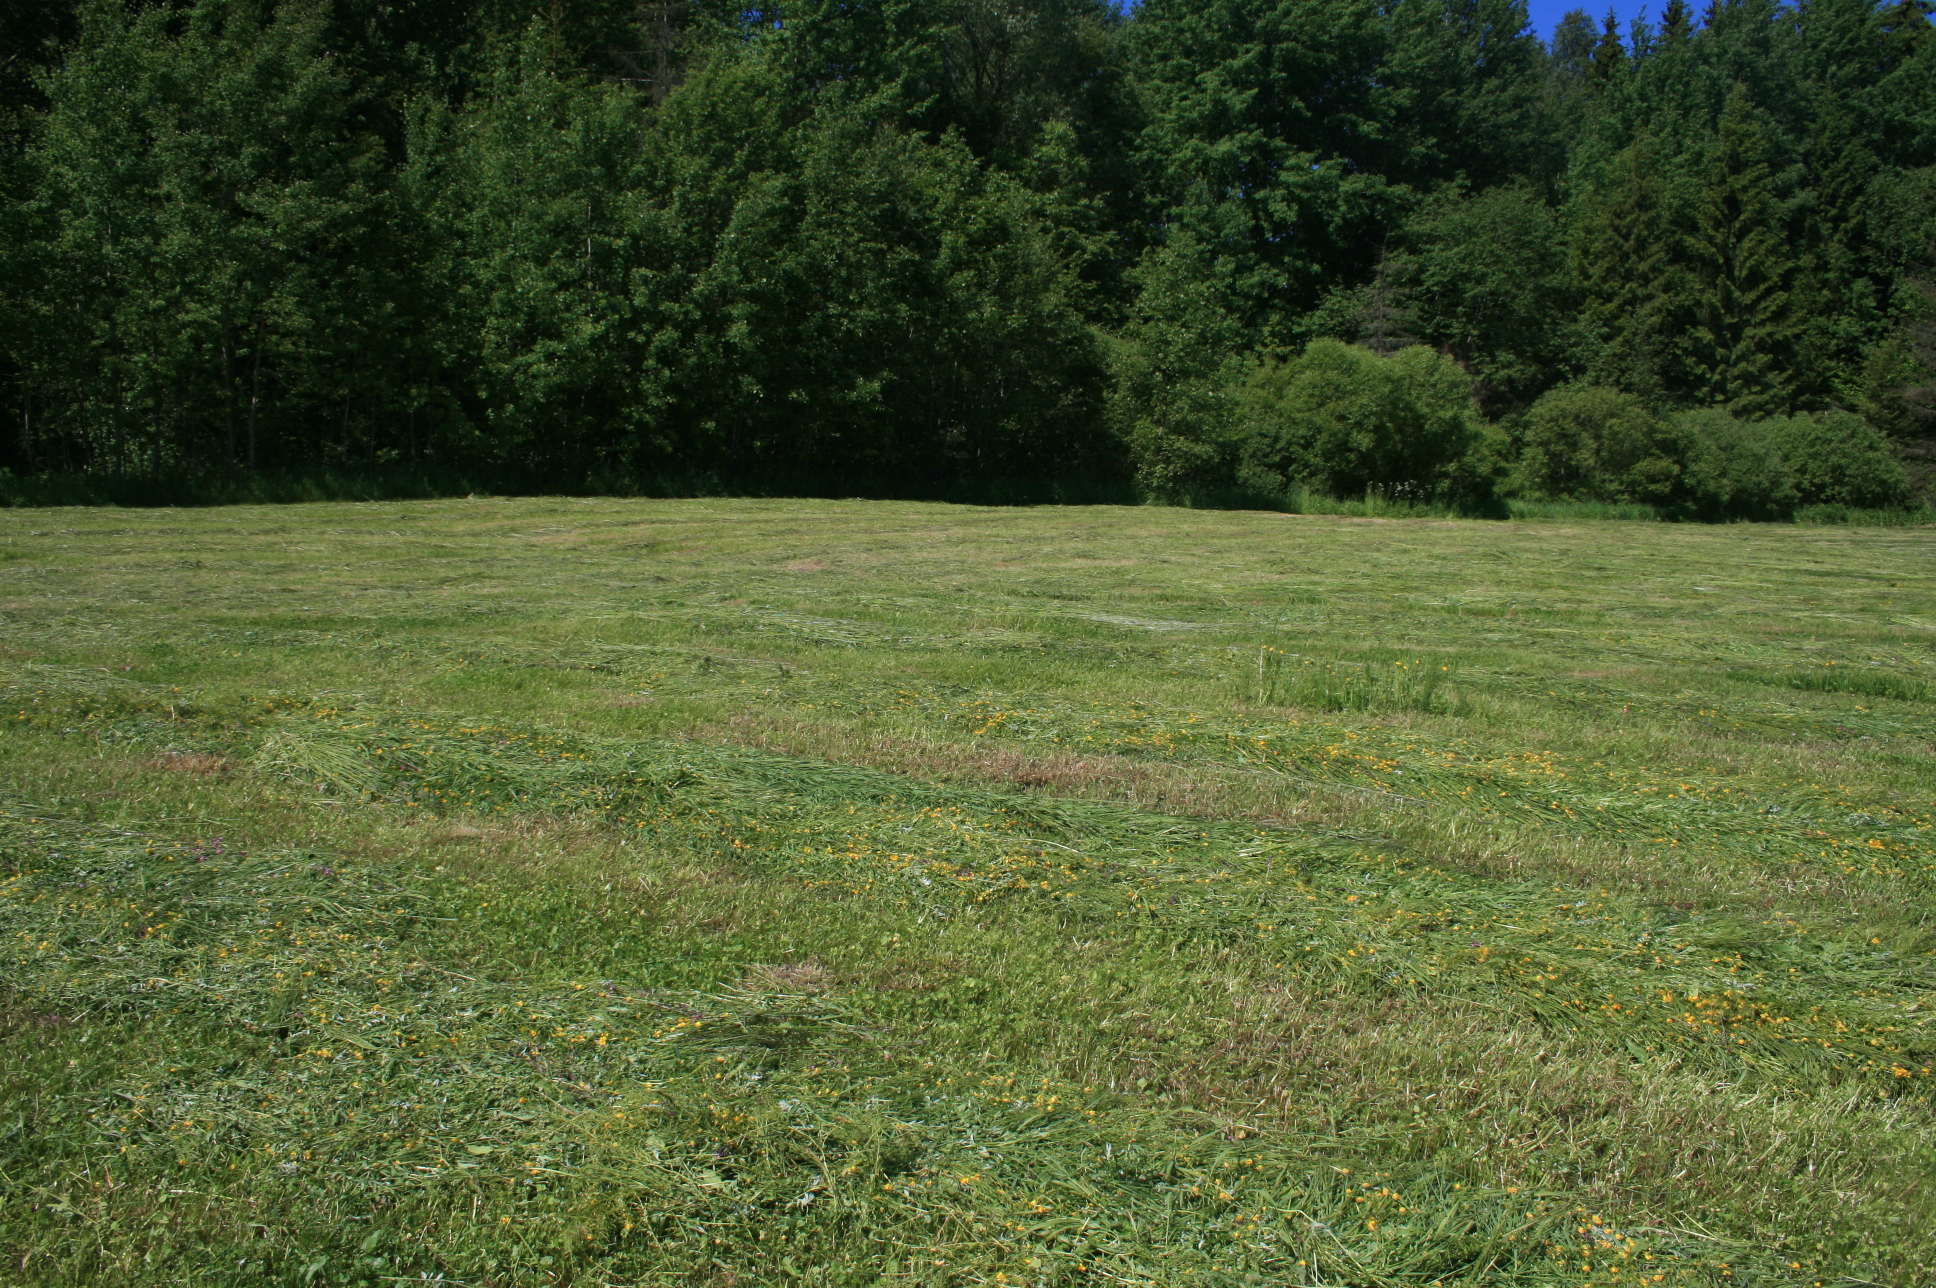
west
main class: Grassland
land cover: Grassland without tree/shrub cover
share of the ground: > 75 %
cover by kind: herbaceous plants 100 %
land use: Agriculture (excluding fallow land and kitchen gardens)
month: June
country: LT
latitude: 55.5769
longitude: 22.0932
